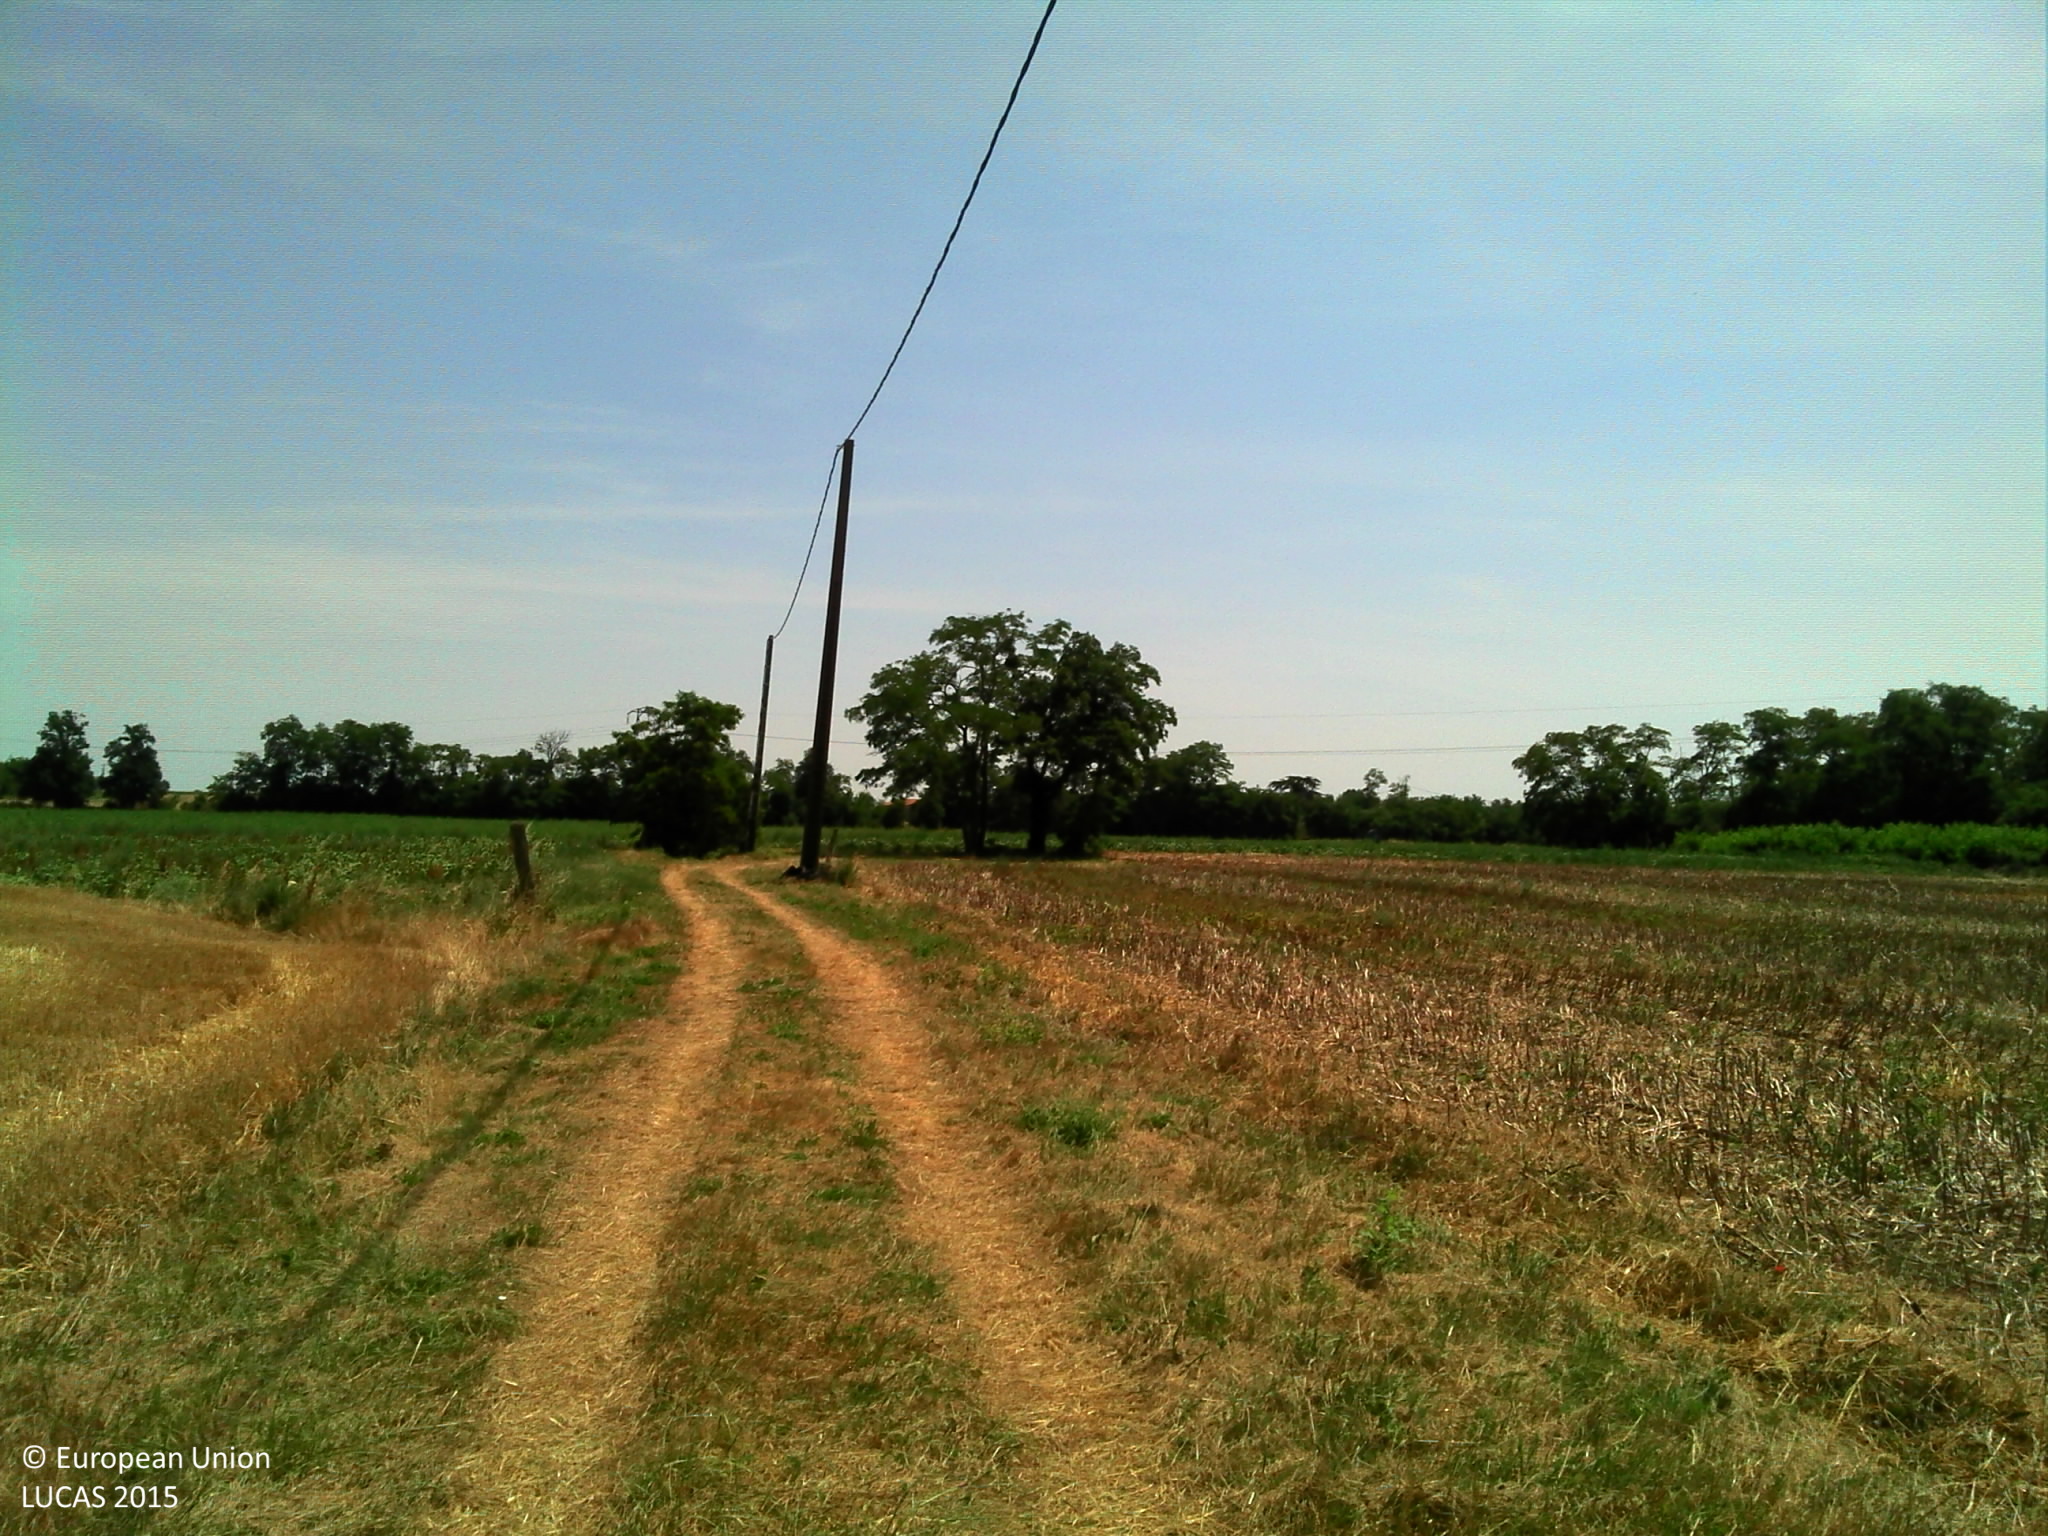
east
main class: Cropland
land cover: Common wheat
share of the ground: > 75 %
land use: Agriculture (excluding fallow land and kitchen gardens)
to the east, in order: Tracks; Artificial constructions in urban areas; Spontaneously vegetated surfaces; Soya; Electric lines; Soya
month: July
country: FR
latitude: 43.1419
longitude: 1.6331
